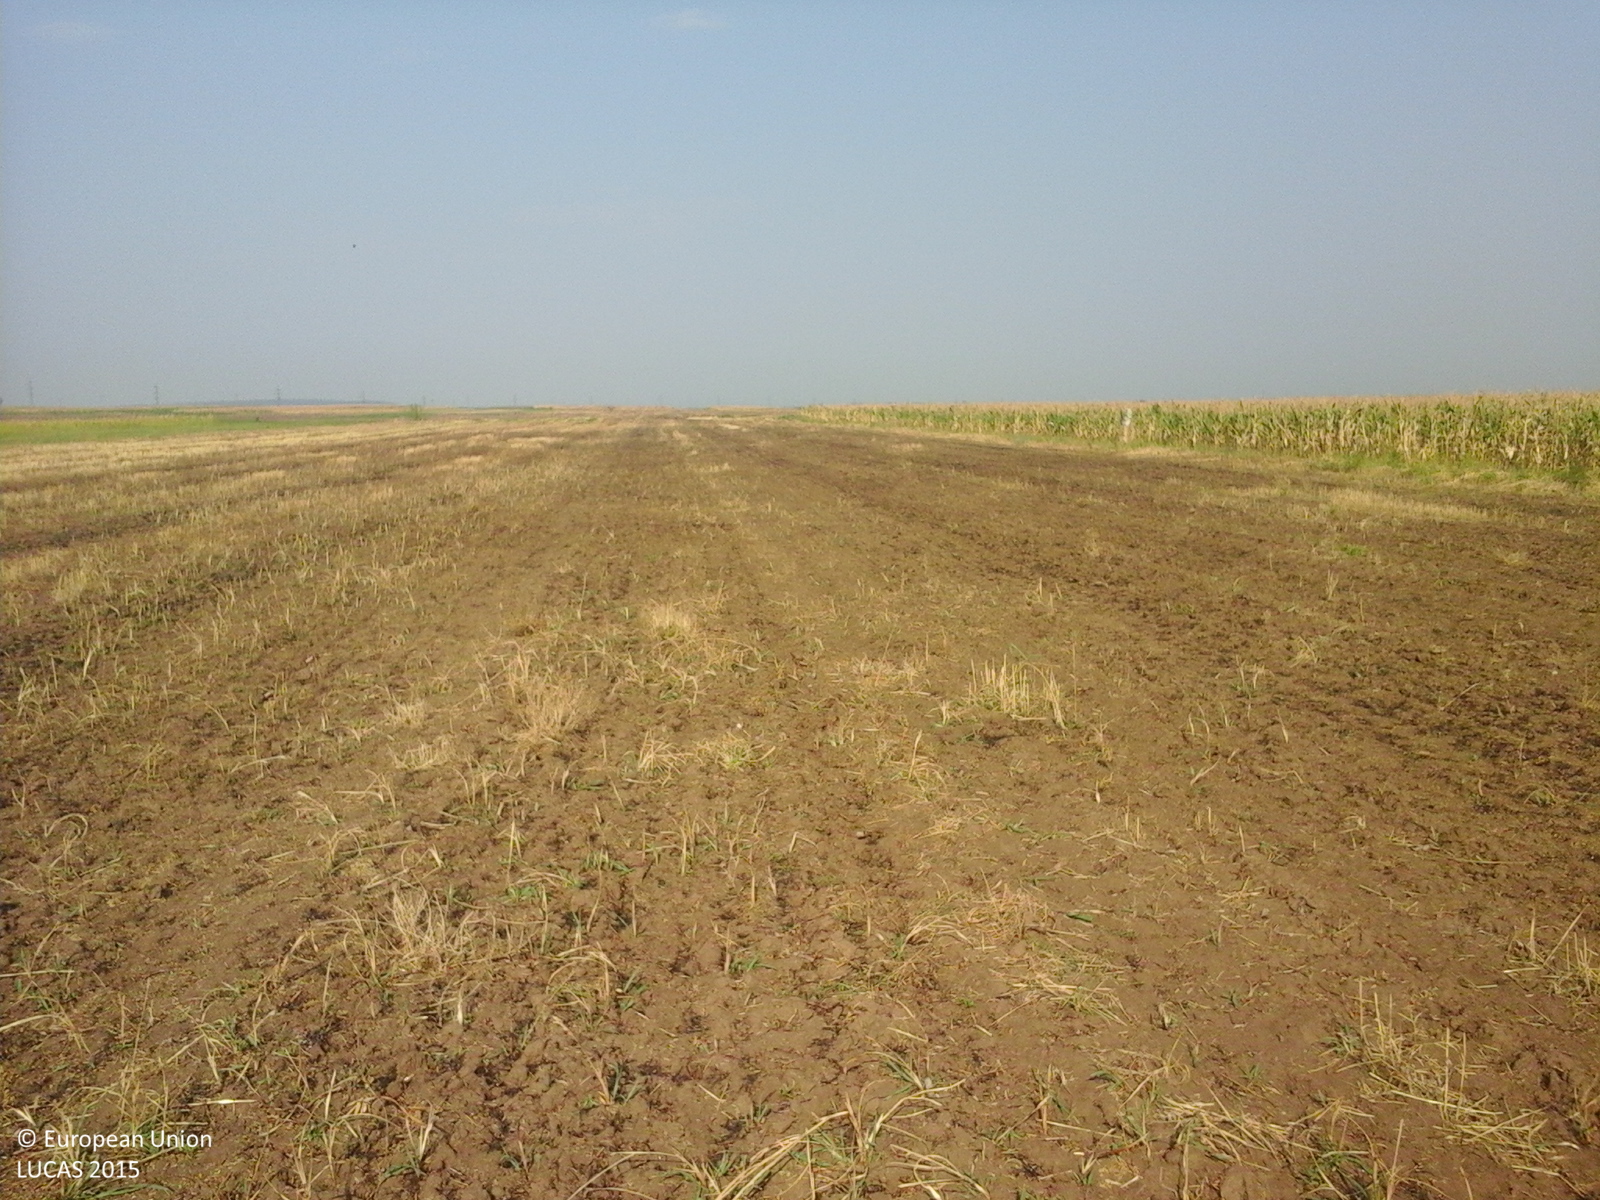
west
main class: Cropland
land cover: Common wheat
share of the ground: < 10 %
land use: Agriculture (excluding fallow land and kitchen gardens)
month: August
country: RO
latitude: 44.1578
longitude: 22.9335
